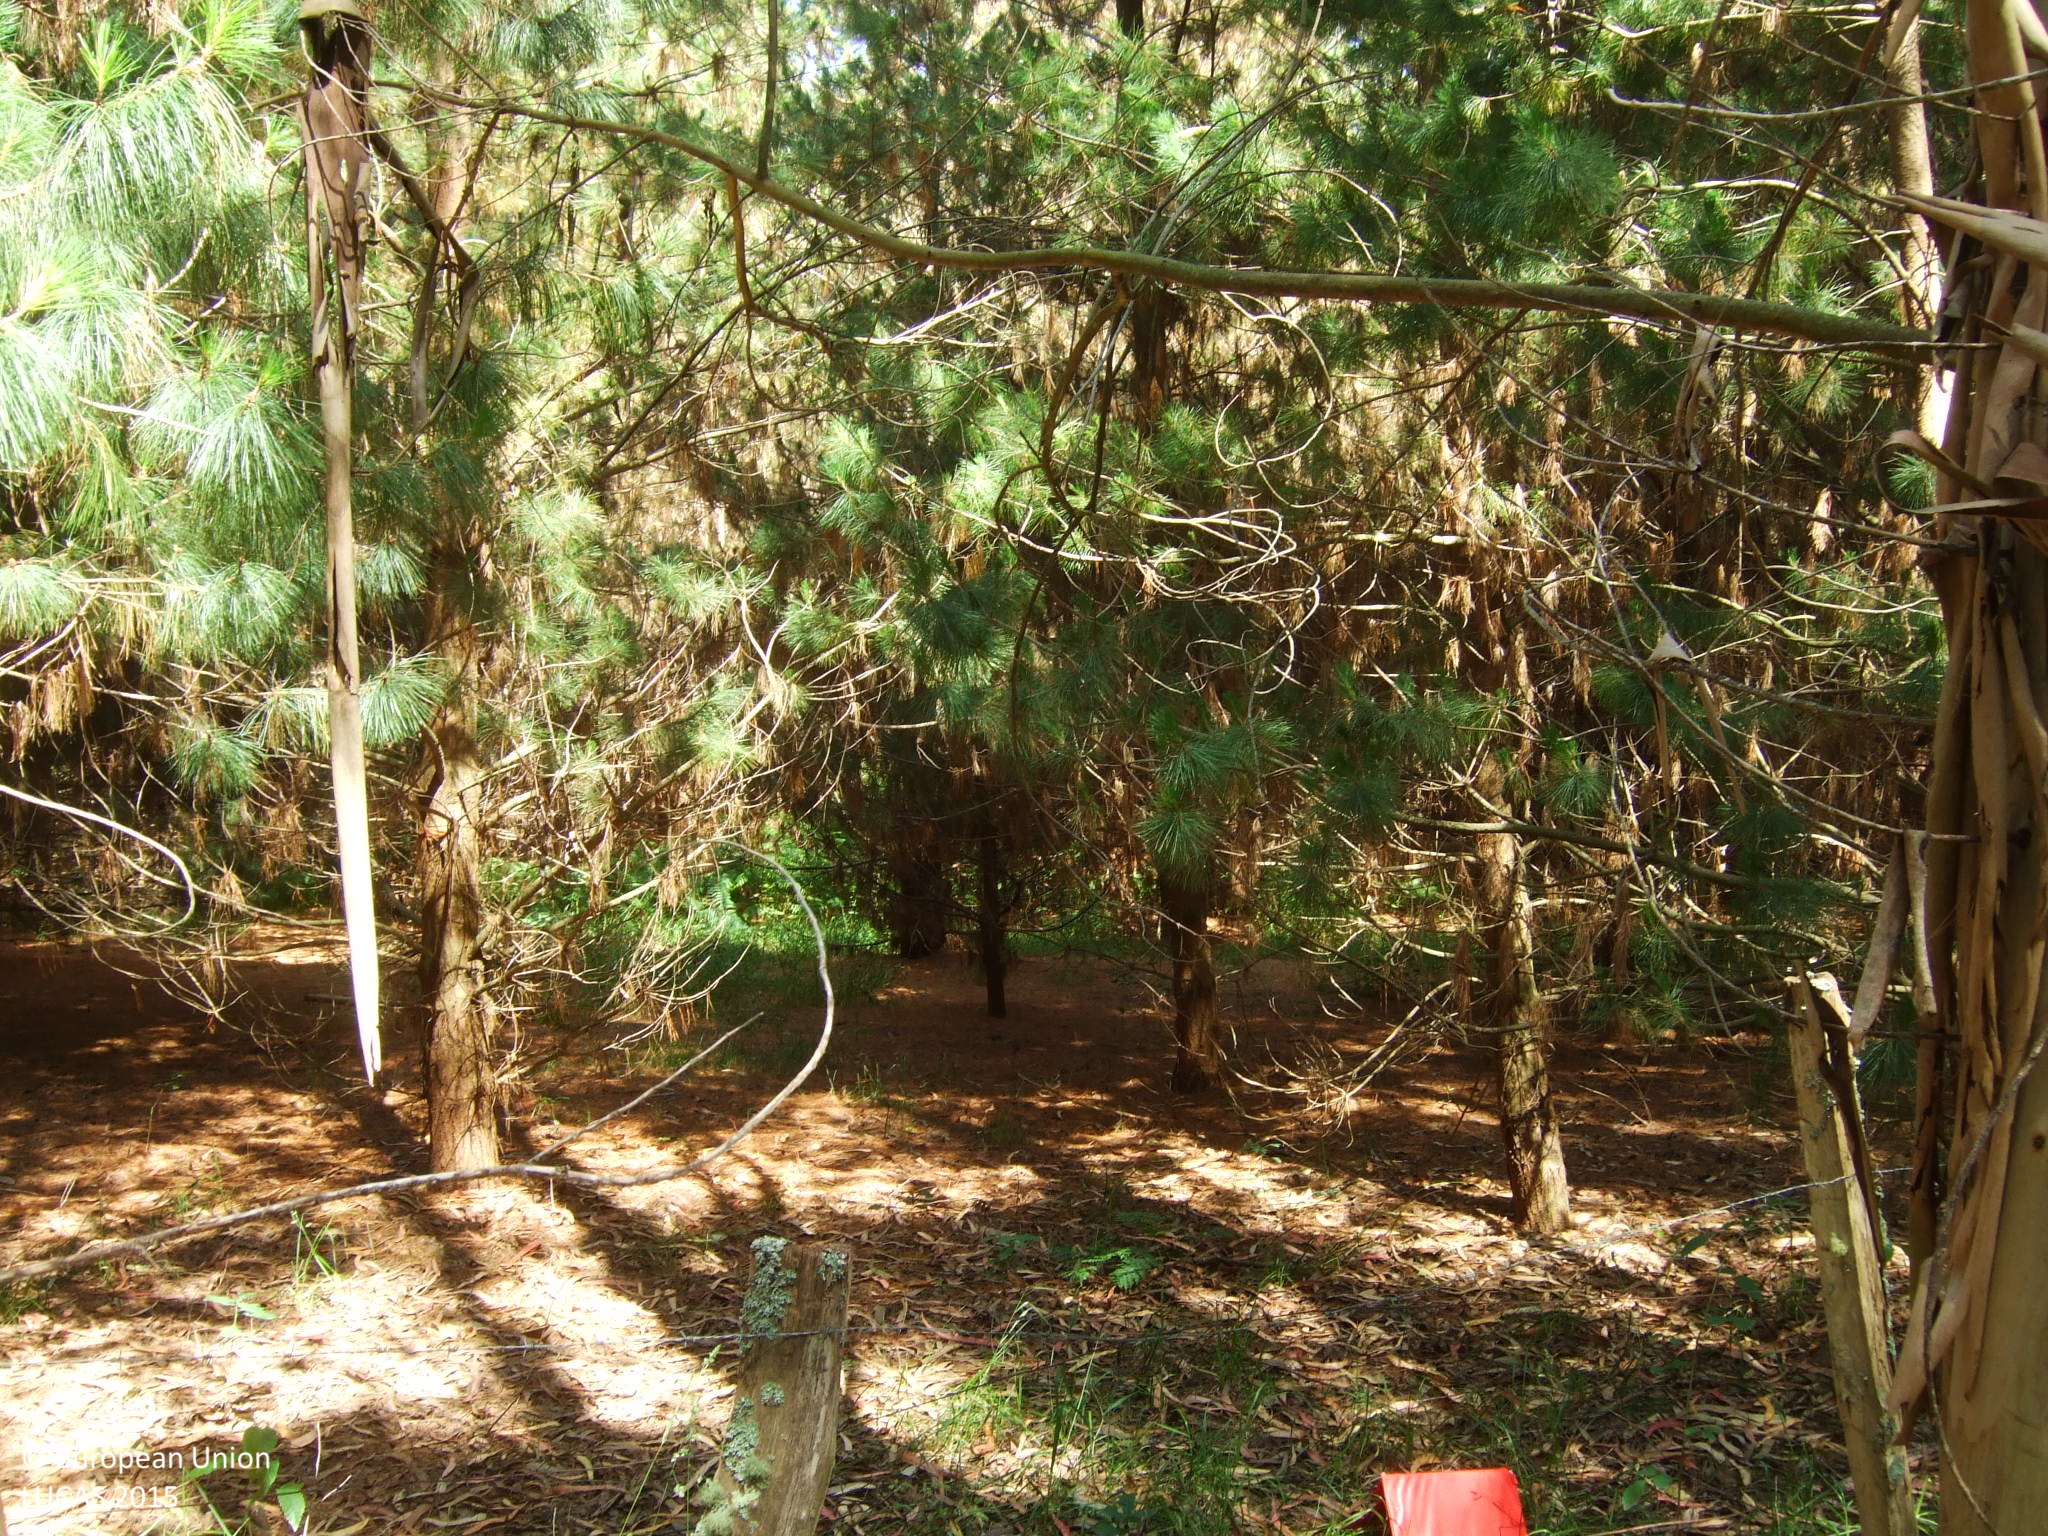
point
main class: Woodland
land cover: Pine dominated coniferous woodland
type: exotic forest
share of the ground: > 75 %
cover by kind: coniferous forest trees 80 %, herbaceous plants 10 %, unconsolidated bare surface 10 %
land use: Forestry
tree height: > 5 m
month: June
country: ES
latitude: 43.5722
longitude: -7.5808
